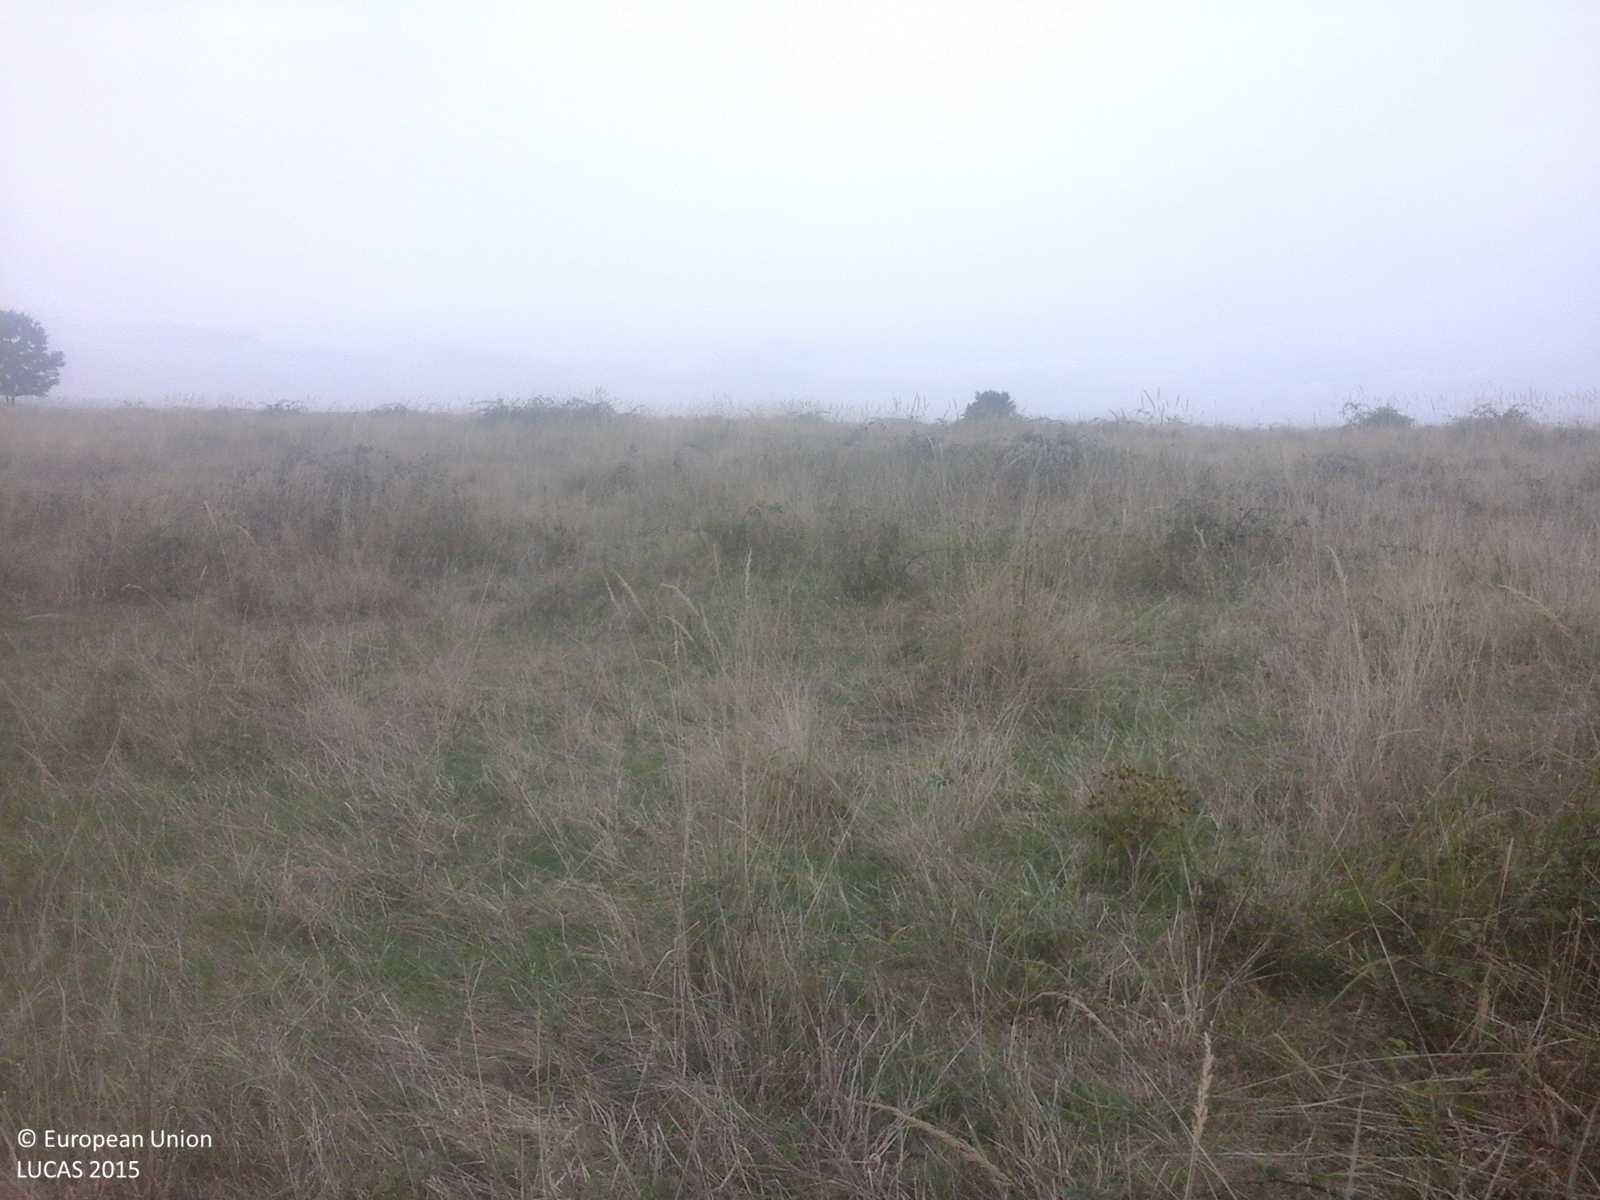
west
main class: Grassland
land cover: Grassland with sparse tree/shrub cover
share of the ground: > 75 %
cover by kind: herbaceous plants 85 %, shrubs 10 %, broadleaved forest trees 5 %
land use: Agriculture (excluding fallow land and kitchen gardens)
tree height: < 5 m
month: September
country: RO
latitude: 45.8605
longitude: 22.1108
